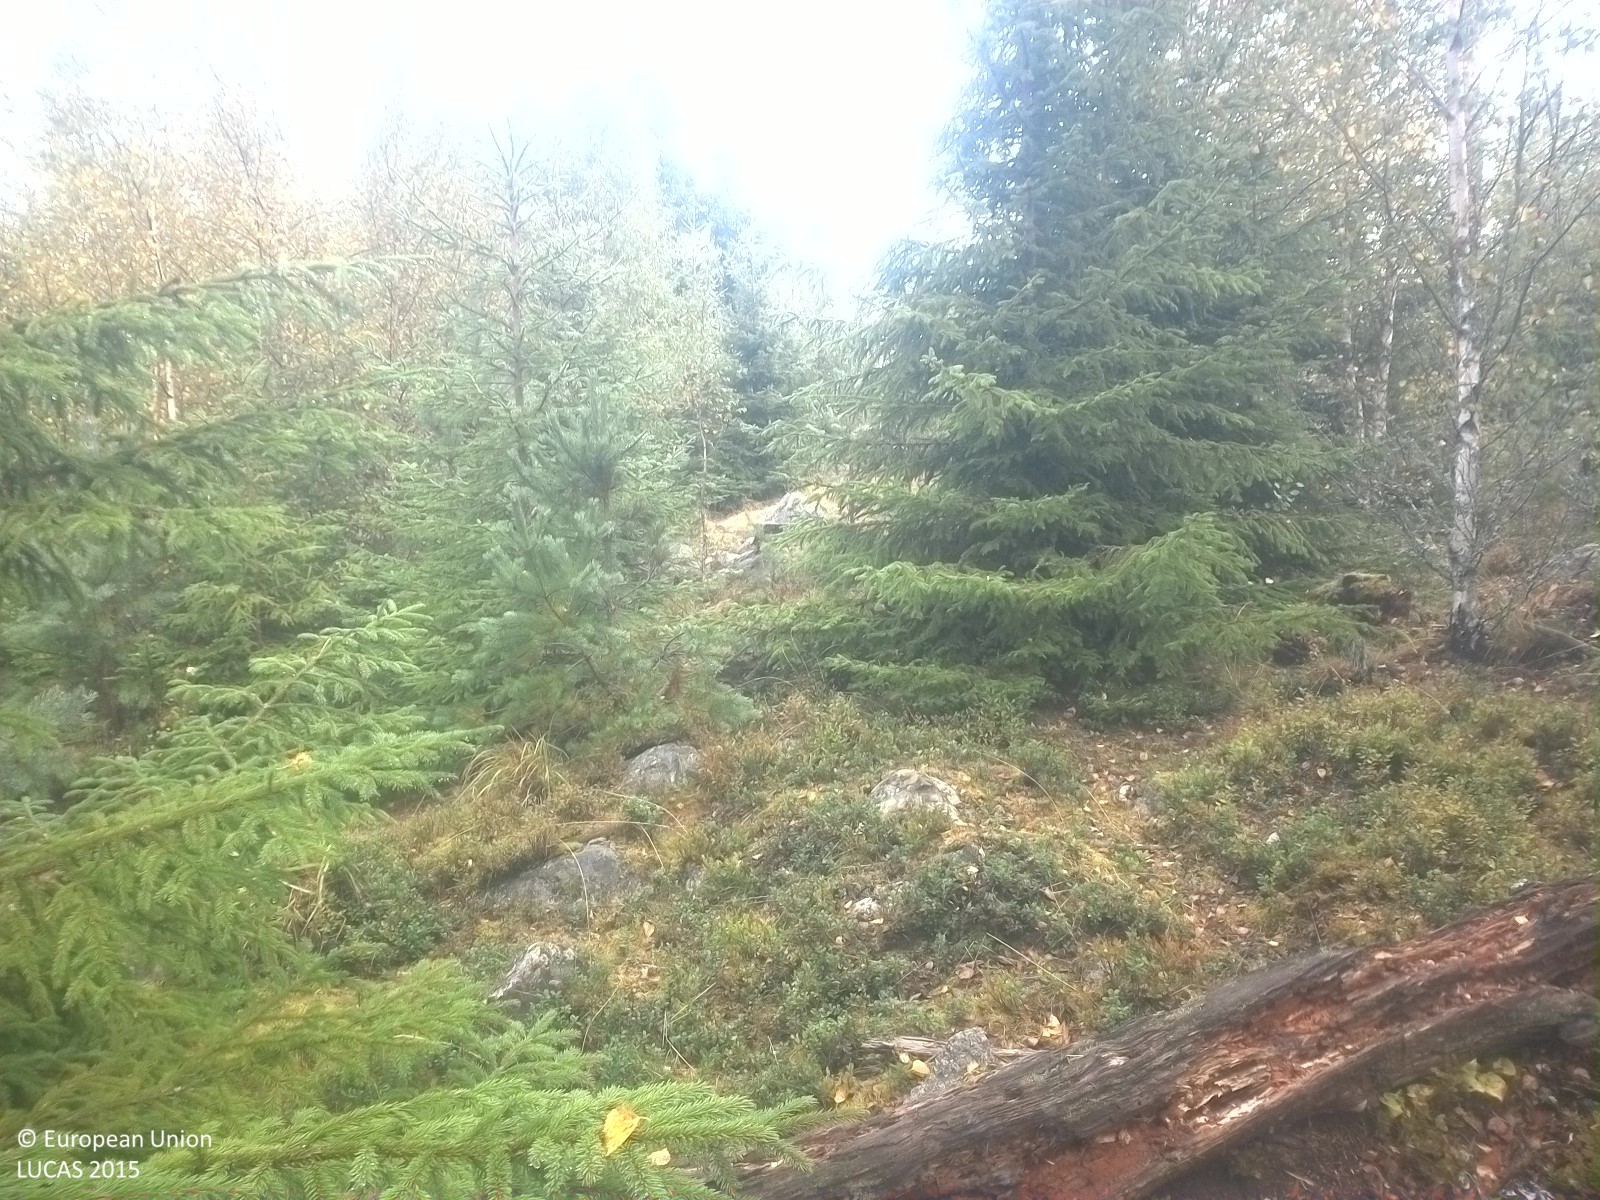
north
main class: Woodland
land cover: Other mixed woodland
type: boreal forest
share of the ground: 25 - 50 %
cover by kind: herbaceous plants 40 %, coniferous forest trees 25 %, lichens and mosses 20 %, broadleaved forest trees 15 %
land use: Forestry
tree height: < 5 m
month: September
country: SE
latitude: 59.3461
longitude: 15.6363
